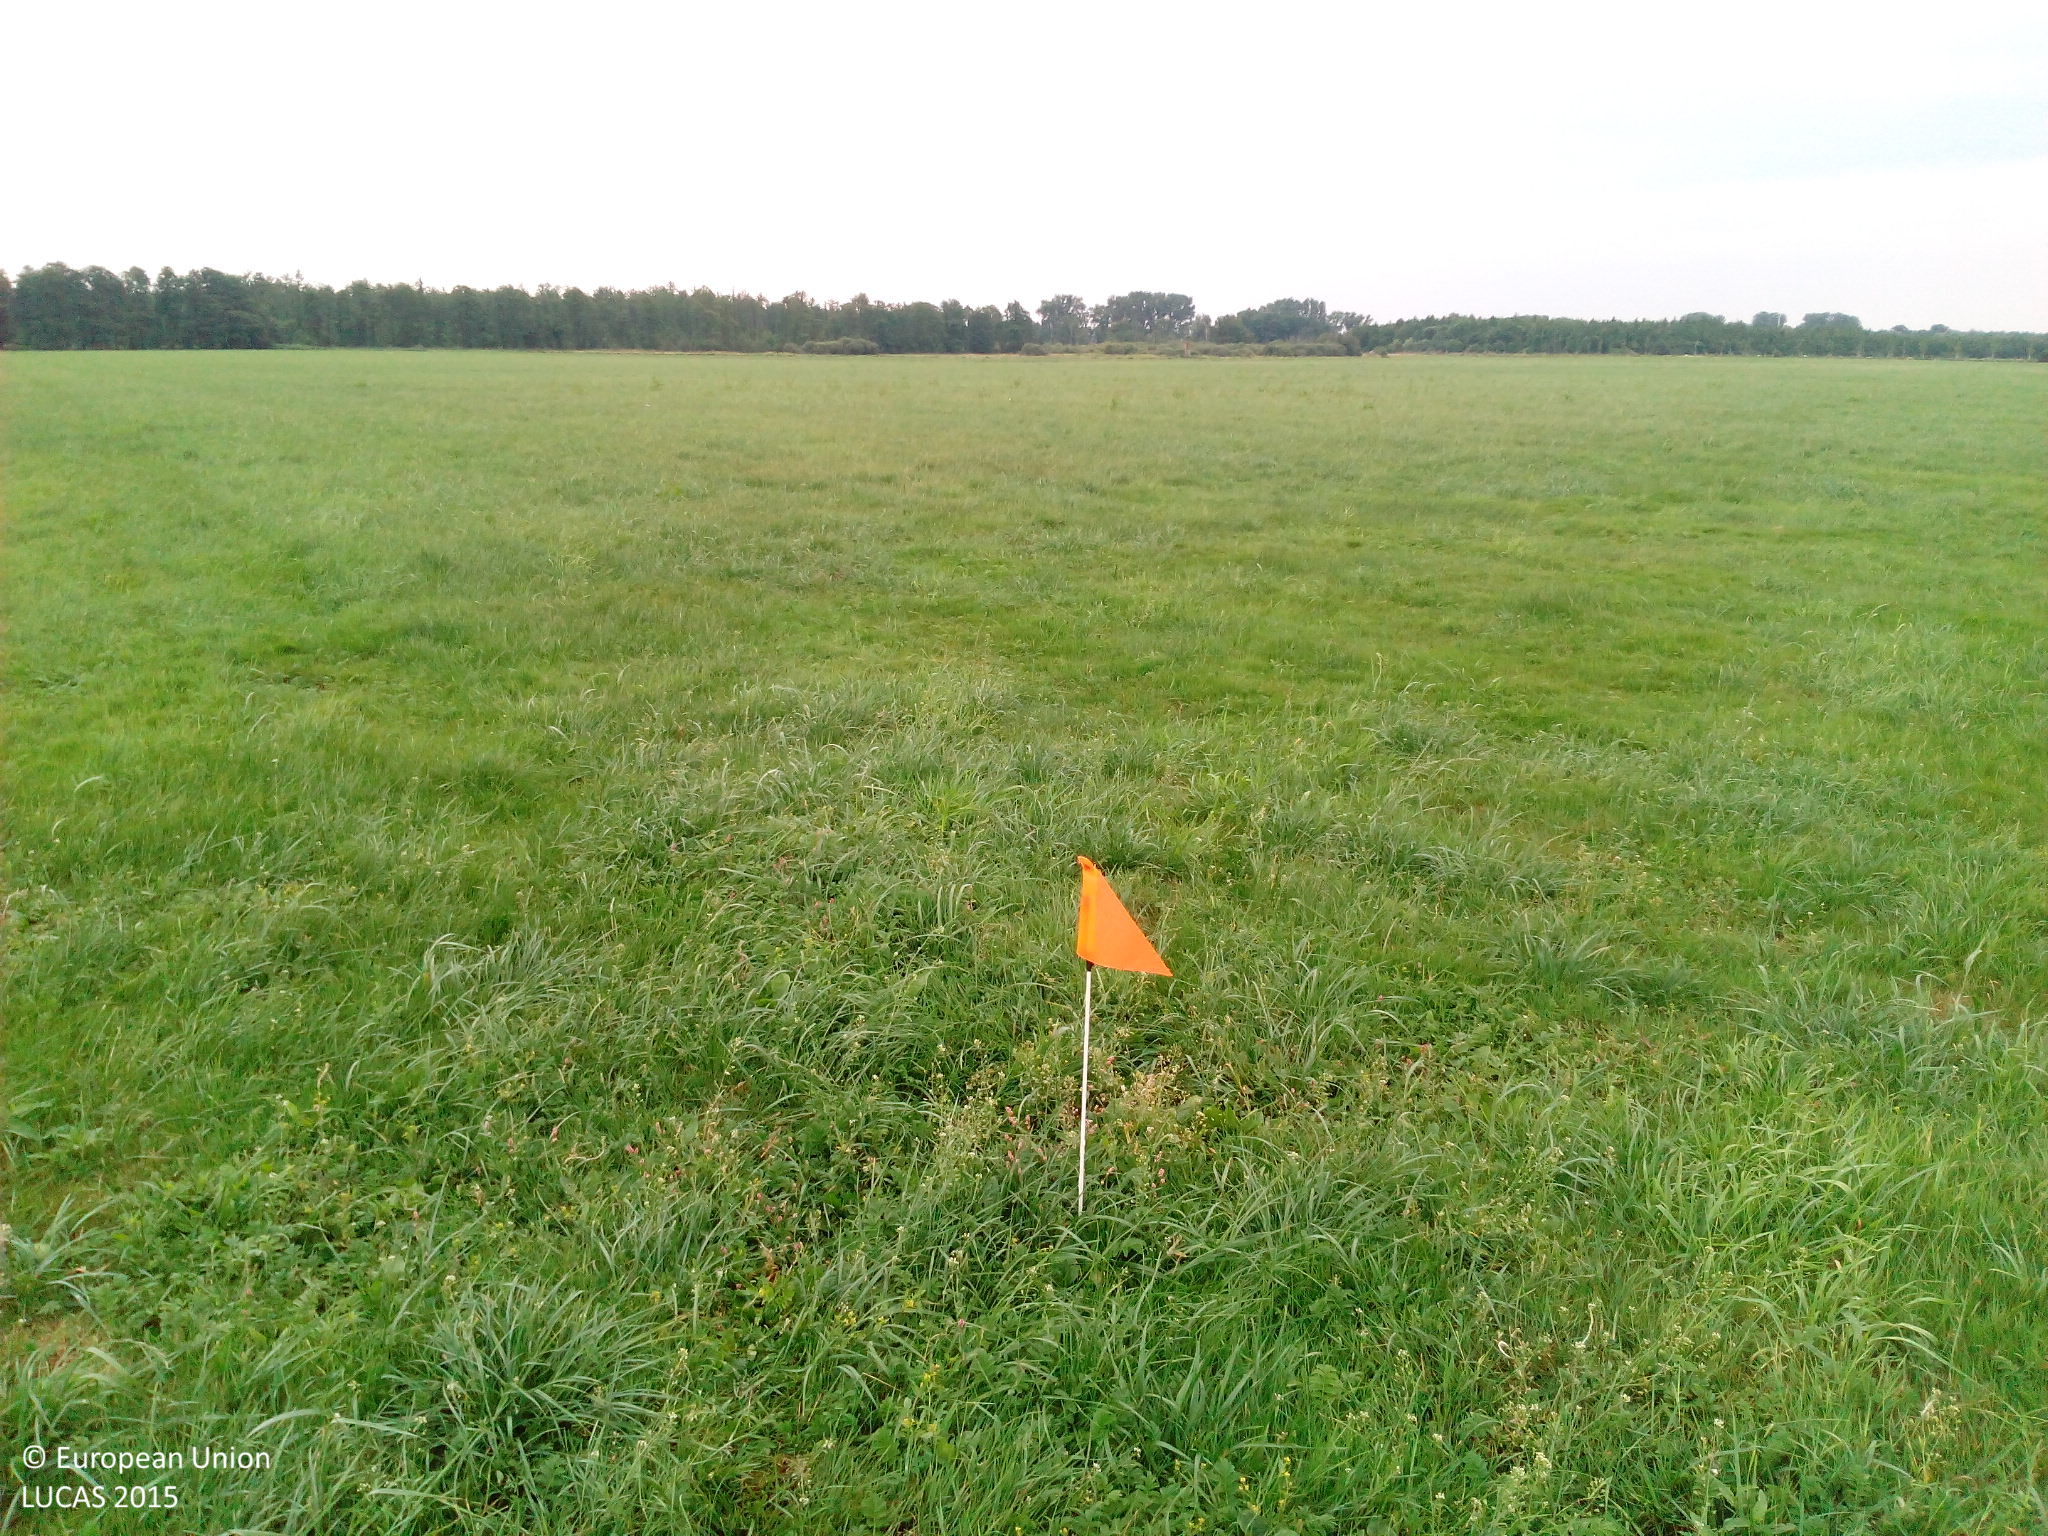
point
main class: Grassland
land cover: Grassland without tree/shrub cover
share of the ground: > 75 %
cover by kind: herbaceous plants 100 %
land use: Agriculture (excluding fallow land and kitchen gardens)
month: August
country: DE
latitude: 53.8237
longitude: 12.5969
